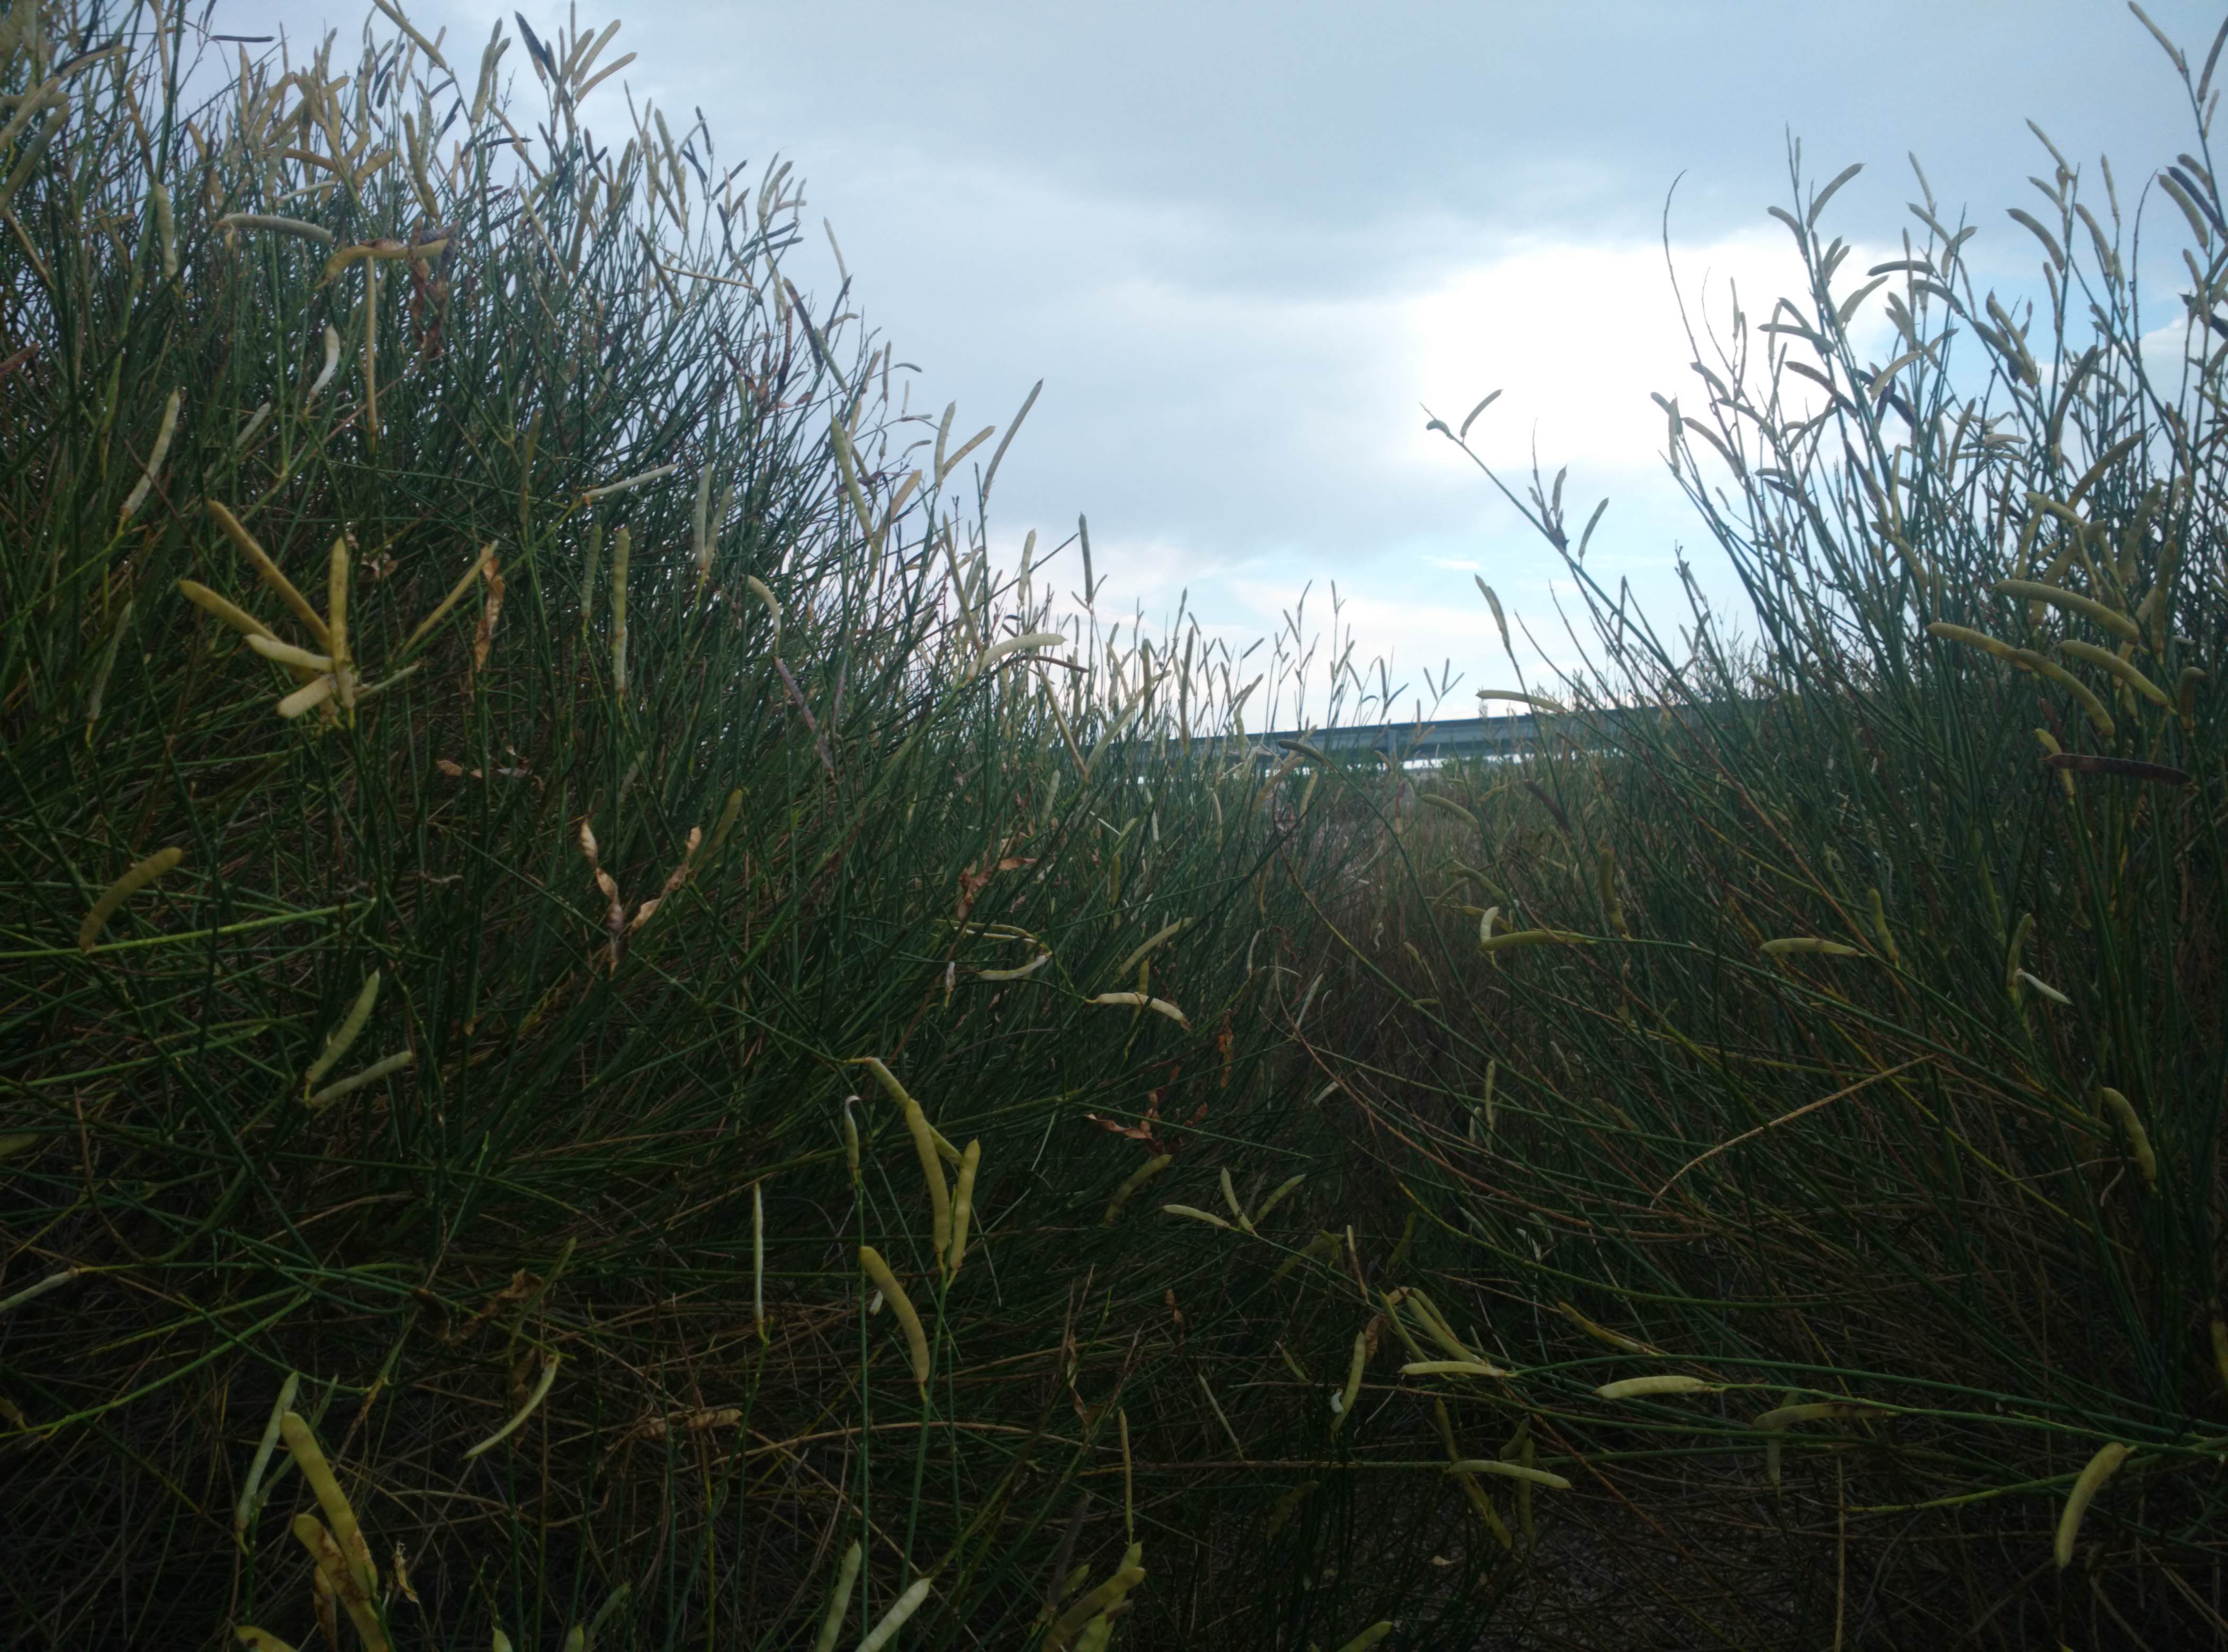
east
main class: Shrubland
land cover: Shrubland without tree cover
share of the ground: 50 - 75 %
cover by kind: shrubs 70 %, unconsolidated bare surface 30 %
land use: Semi-natural and natural areas not in use
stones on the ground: > 50 %
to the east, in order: Shrubland without tree cover; Fences; Paved roads, cycling and walking lanes; Abandoned hedges; Paved roads, cycling and walking lanes; Fences; Shrubland without tree cover; Tracks; Abandoned hedges; Spontaneously vegetated surfaces; Tracks
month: July
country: ES
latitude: 40.9639
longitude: -2.6380
